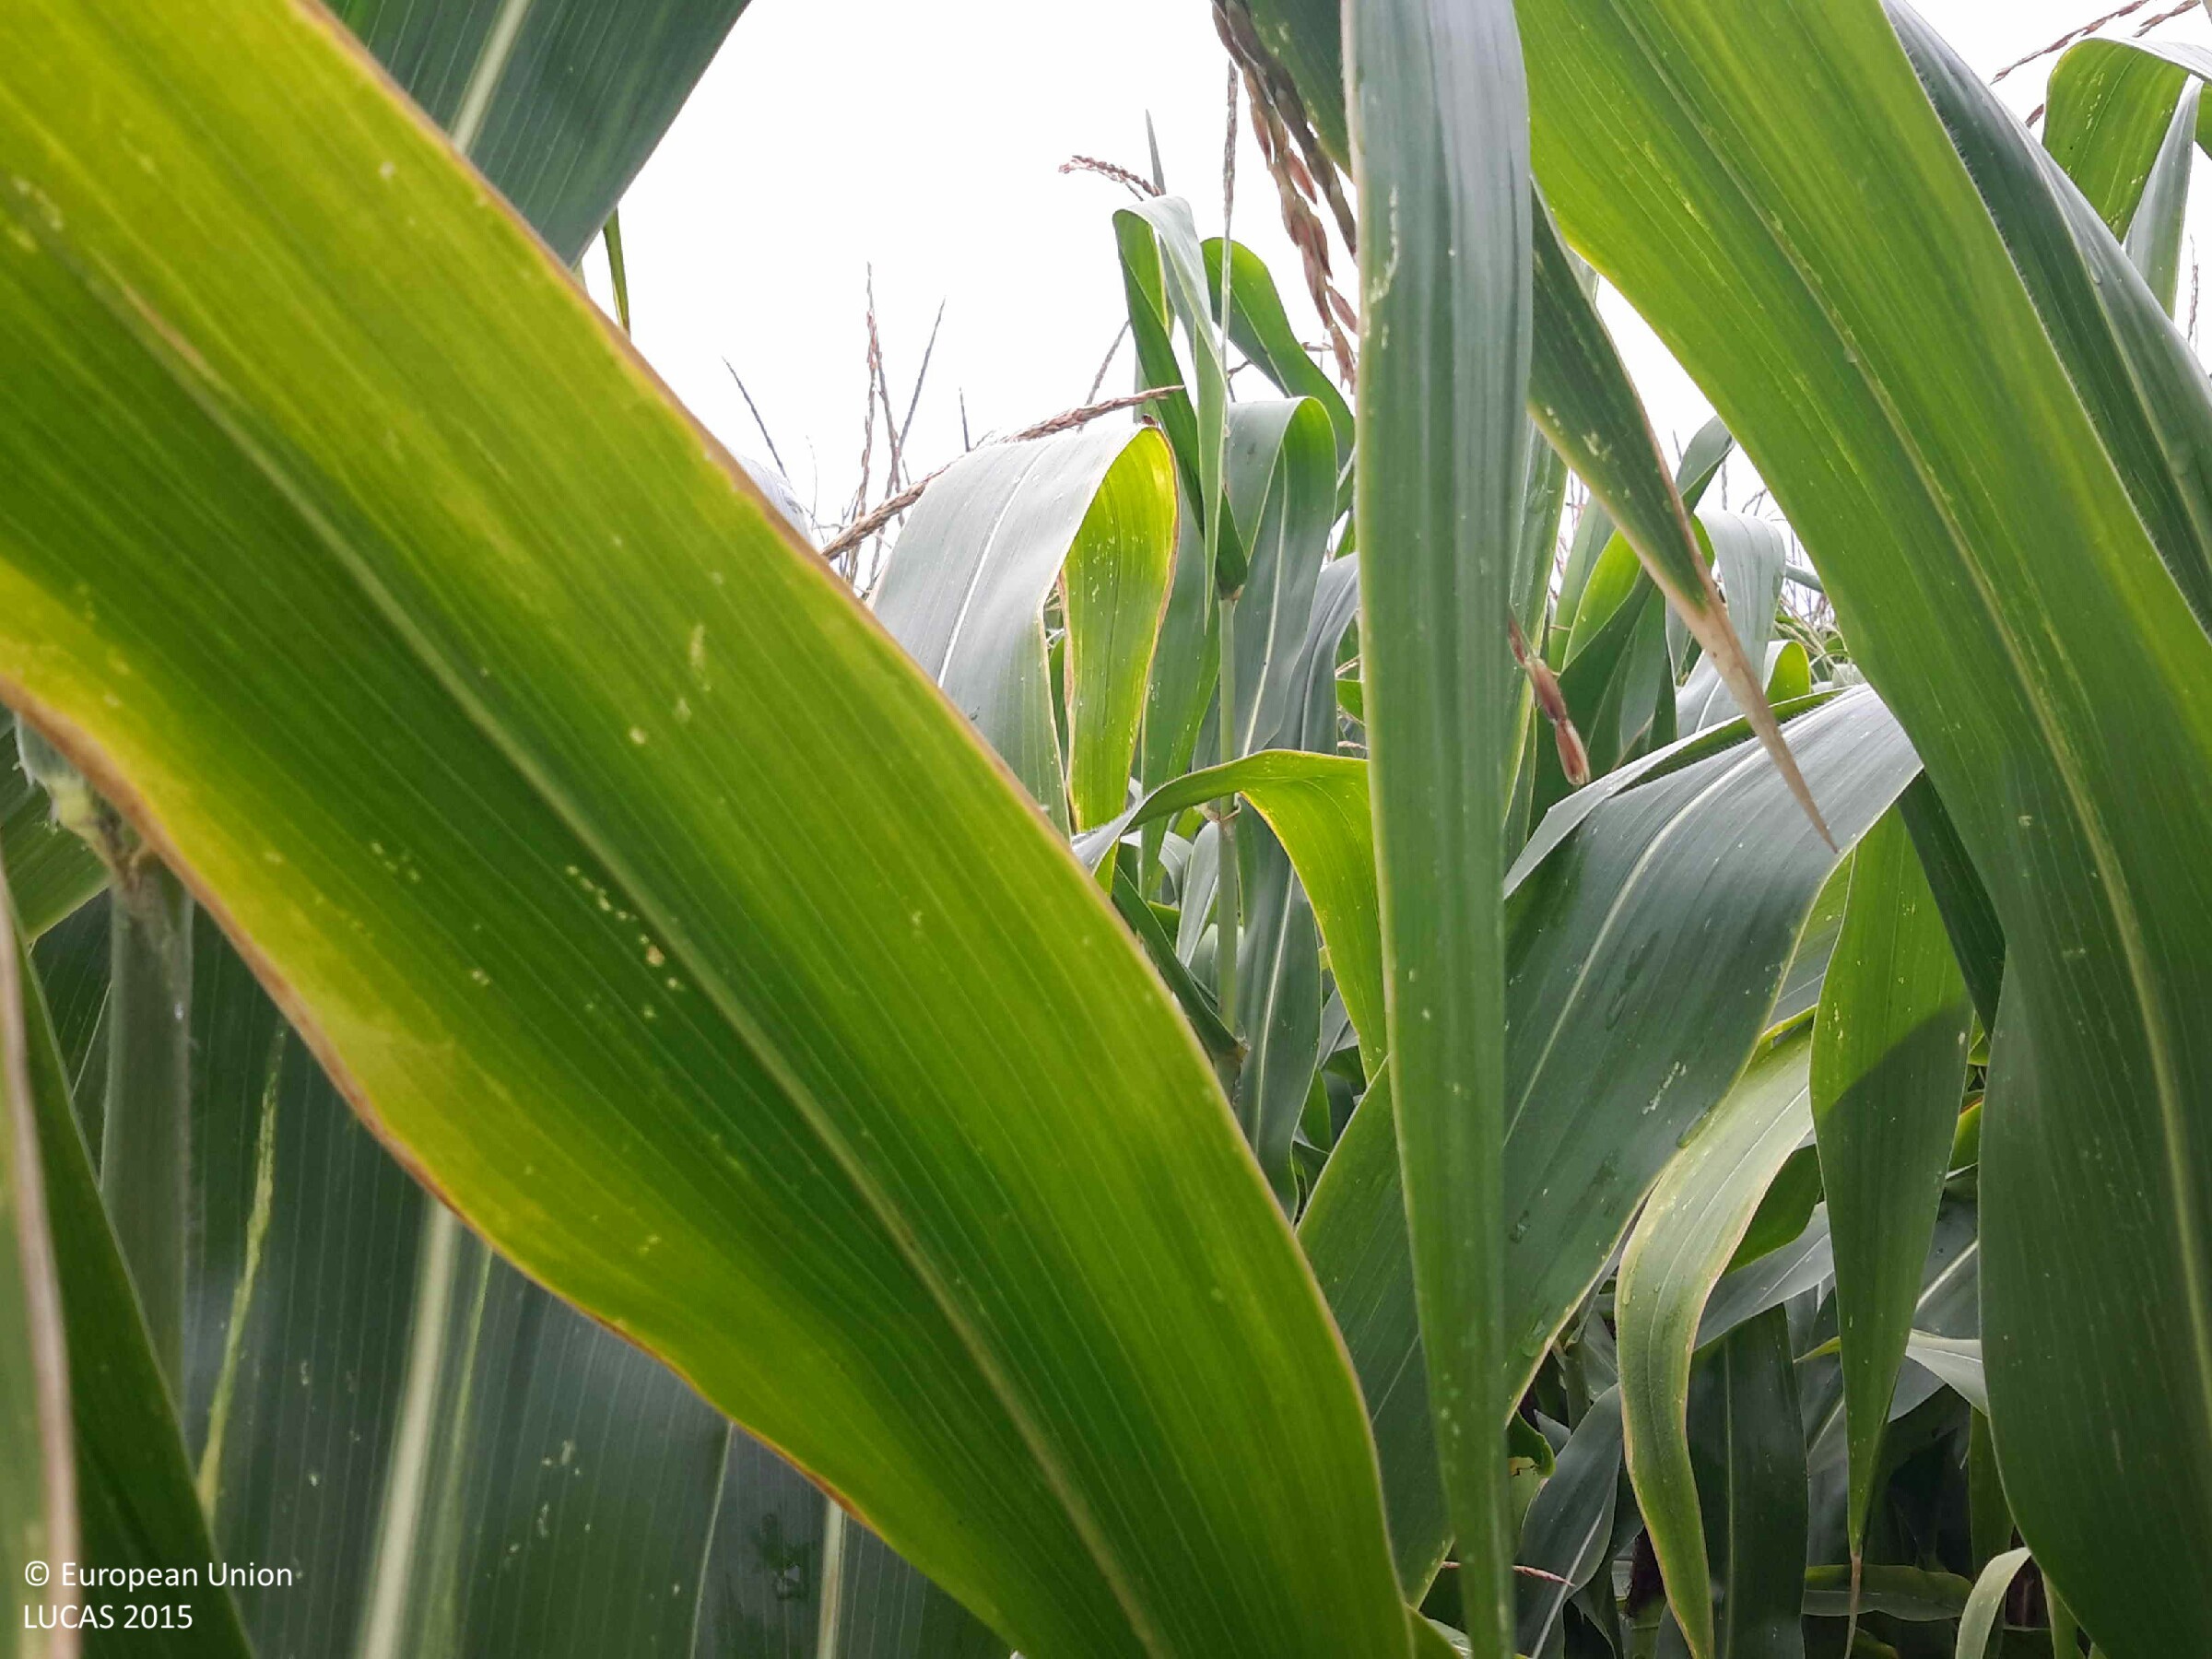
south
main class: Cropland
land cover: Maize
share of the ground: > 75 %
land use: Agriculture (excluding fallow land and kitchen gardens)
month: July
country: HU
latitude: 47.6029
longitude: 17.5504
